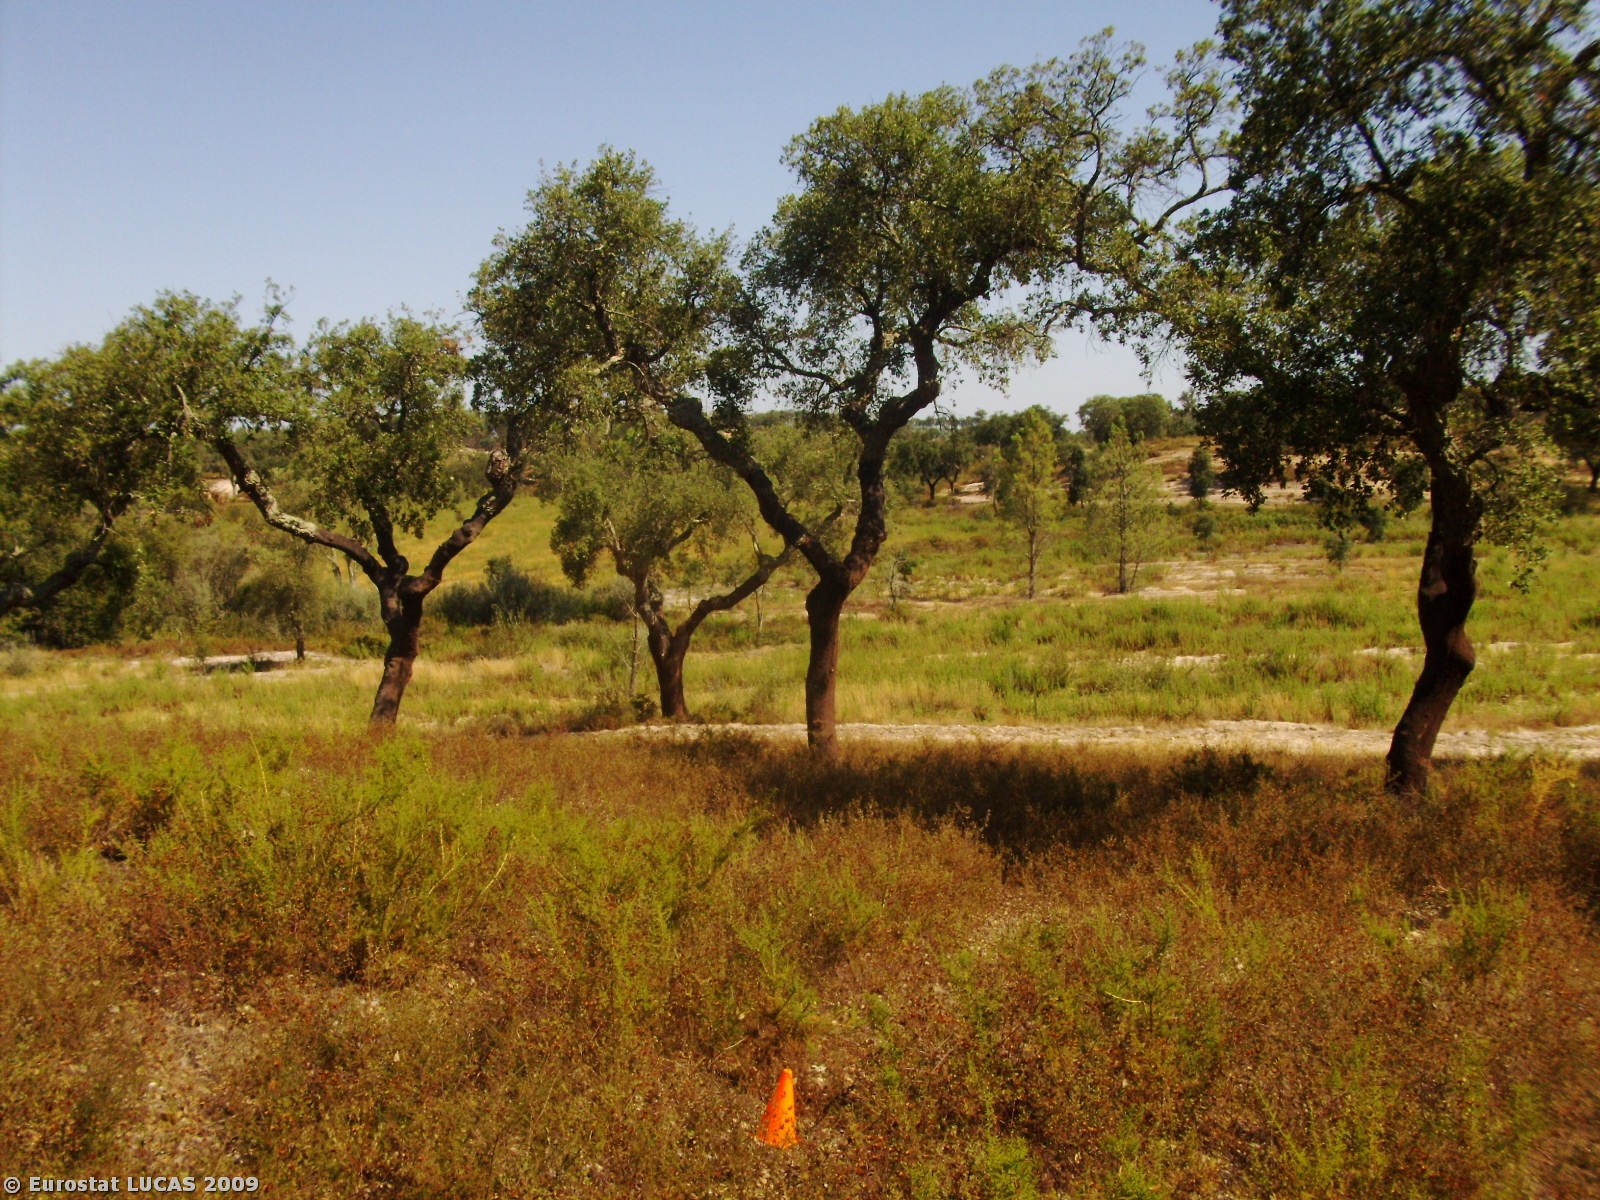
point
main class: Woodland
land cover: Broadleaved woodland
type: broadleaved evergreen forest
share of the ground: 25 - 50 %
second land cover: Spontaneously vegetated surfaces
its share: 25 - 50 %
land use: Forestry
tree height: > 5 m
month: August
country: PT
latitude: 39.2696
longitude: -8.1045
